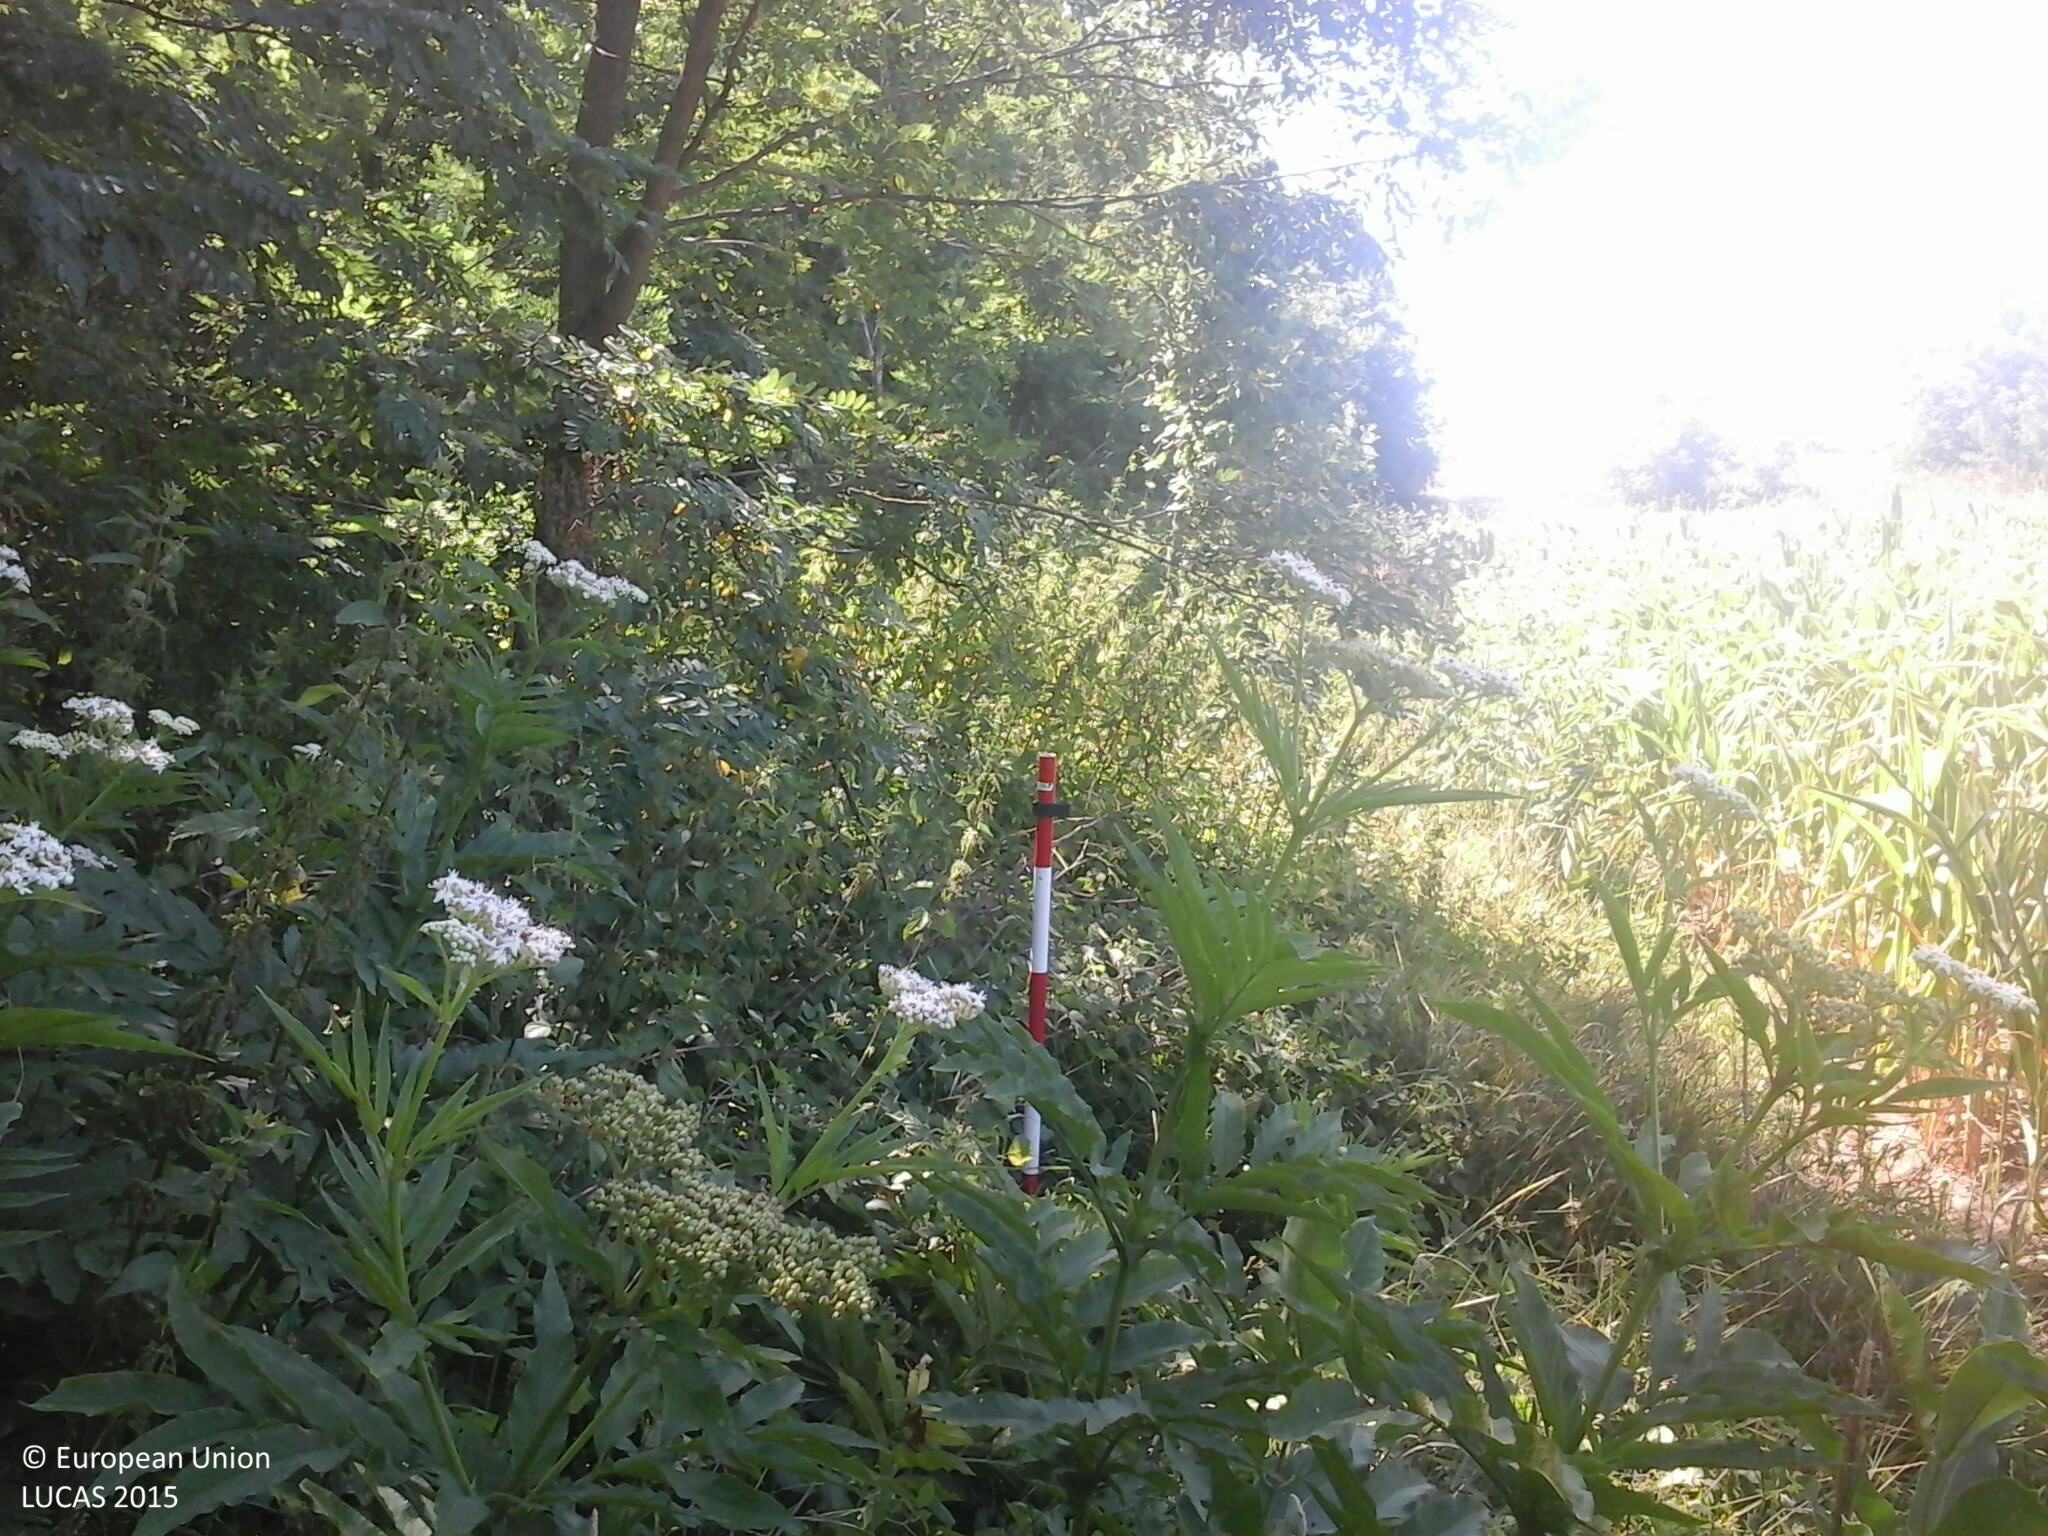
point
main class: Woodland
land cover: Broadleaved woodland
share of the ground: 50 - 75 %
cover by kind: broadleaved forest trees 90 %, herbaceous plants 10 %
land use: Forestry
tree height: > 5 m
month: July
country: HU
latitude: 47.8488
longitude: 21.9035
